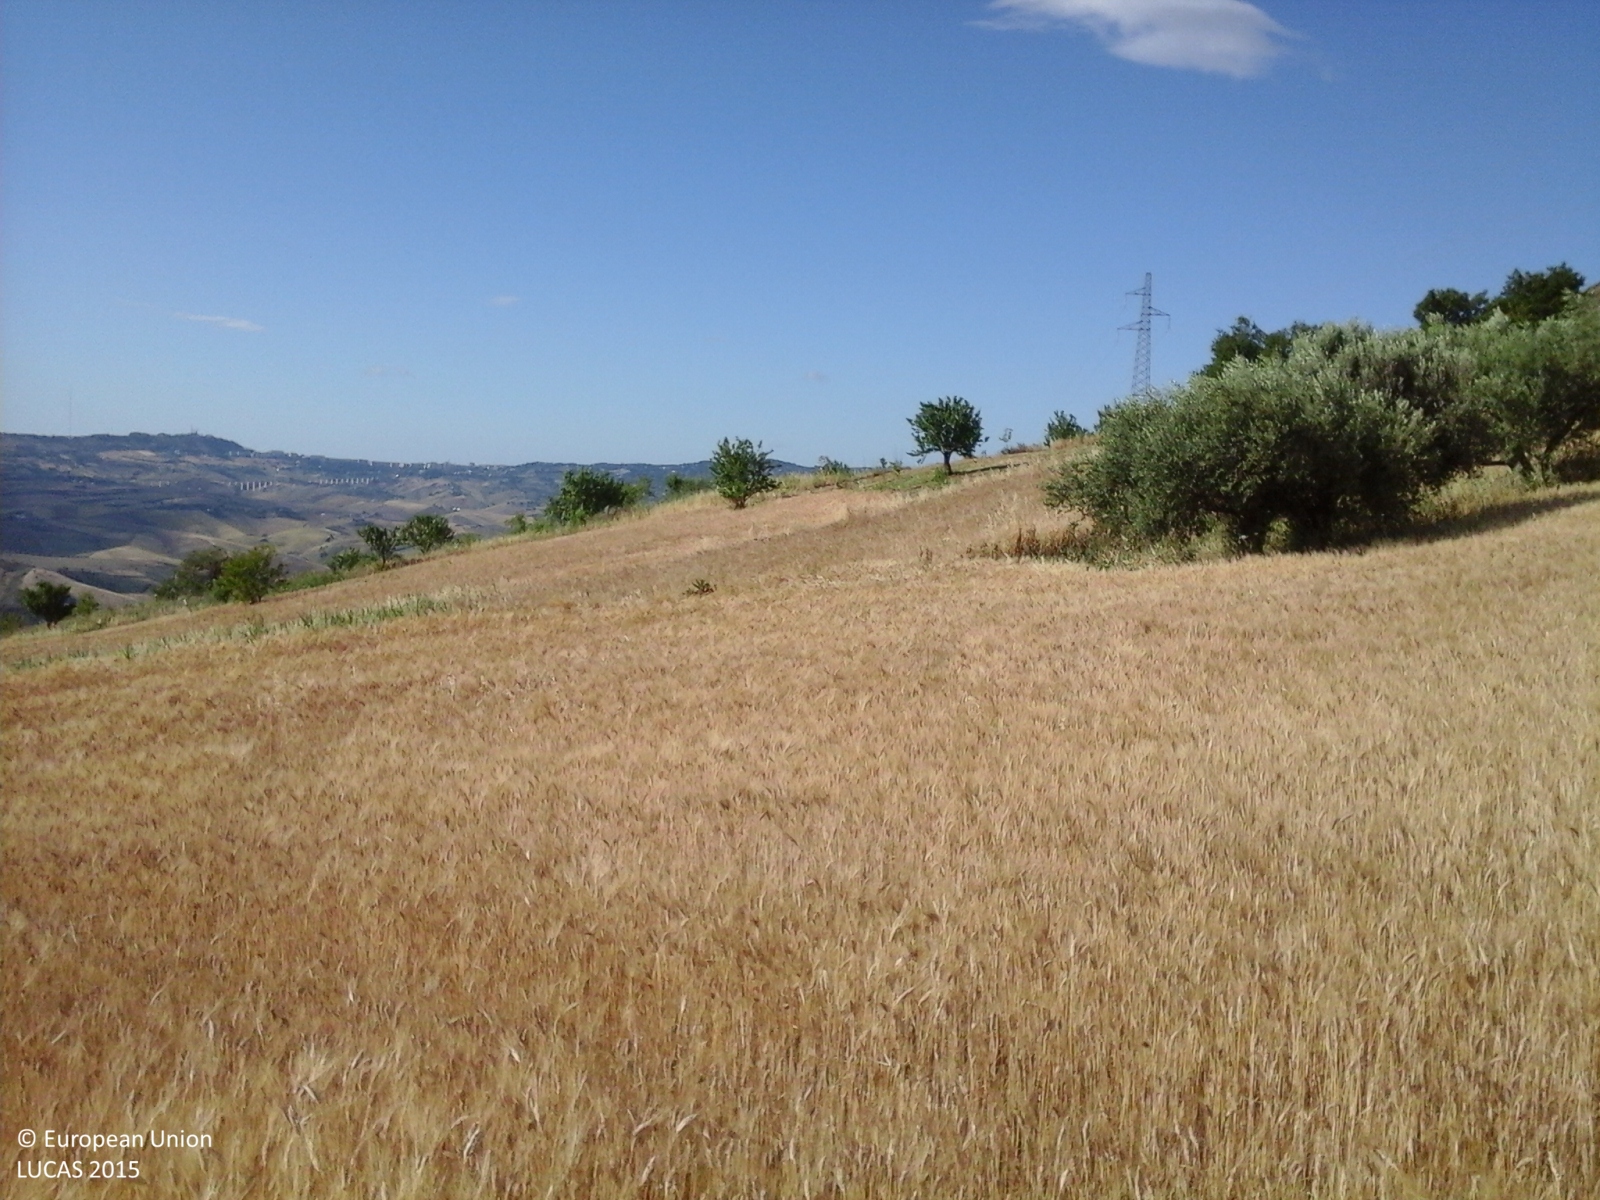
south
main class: Cropland
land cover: Durum wheat
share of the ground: > 75 %
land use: Agriculture (excluding fallow land and kitchen gardens)
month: June
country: IT
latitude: 37.5720
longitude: 14.0124
